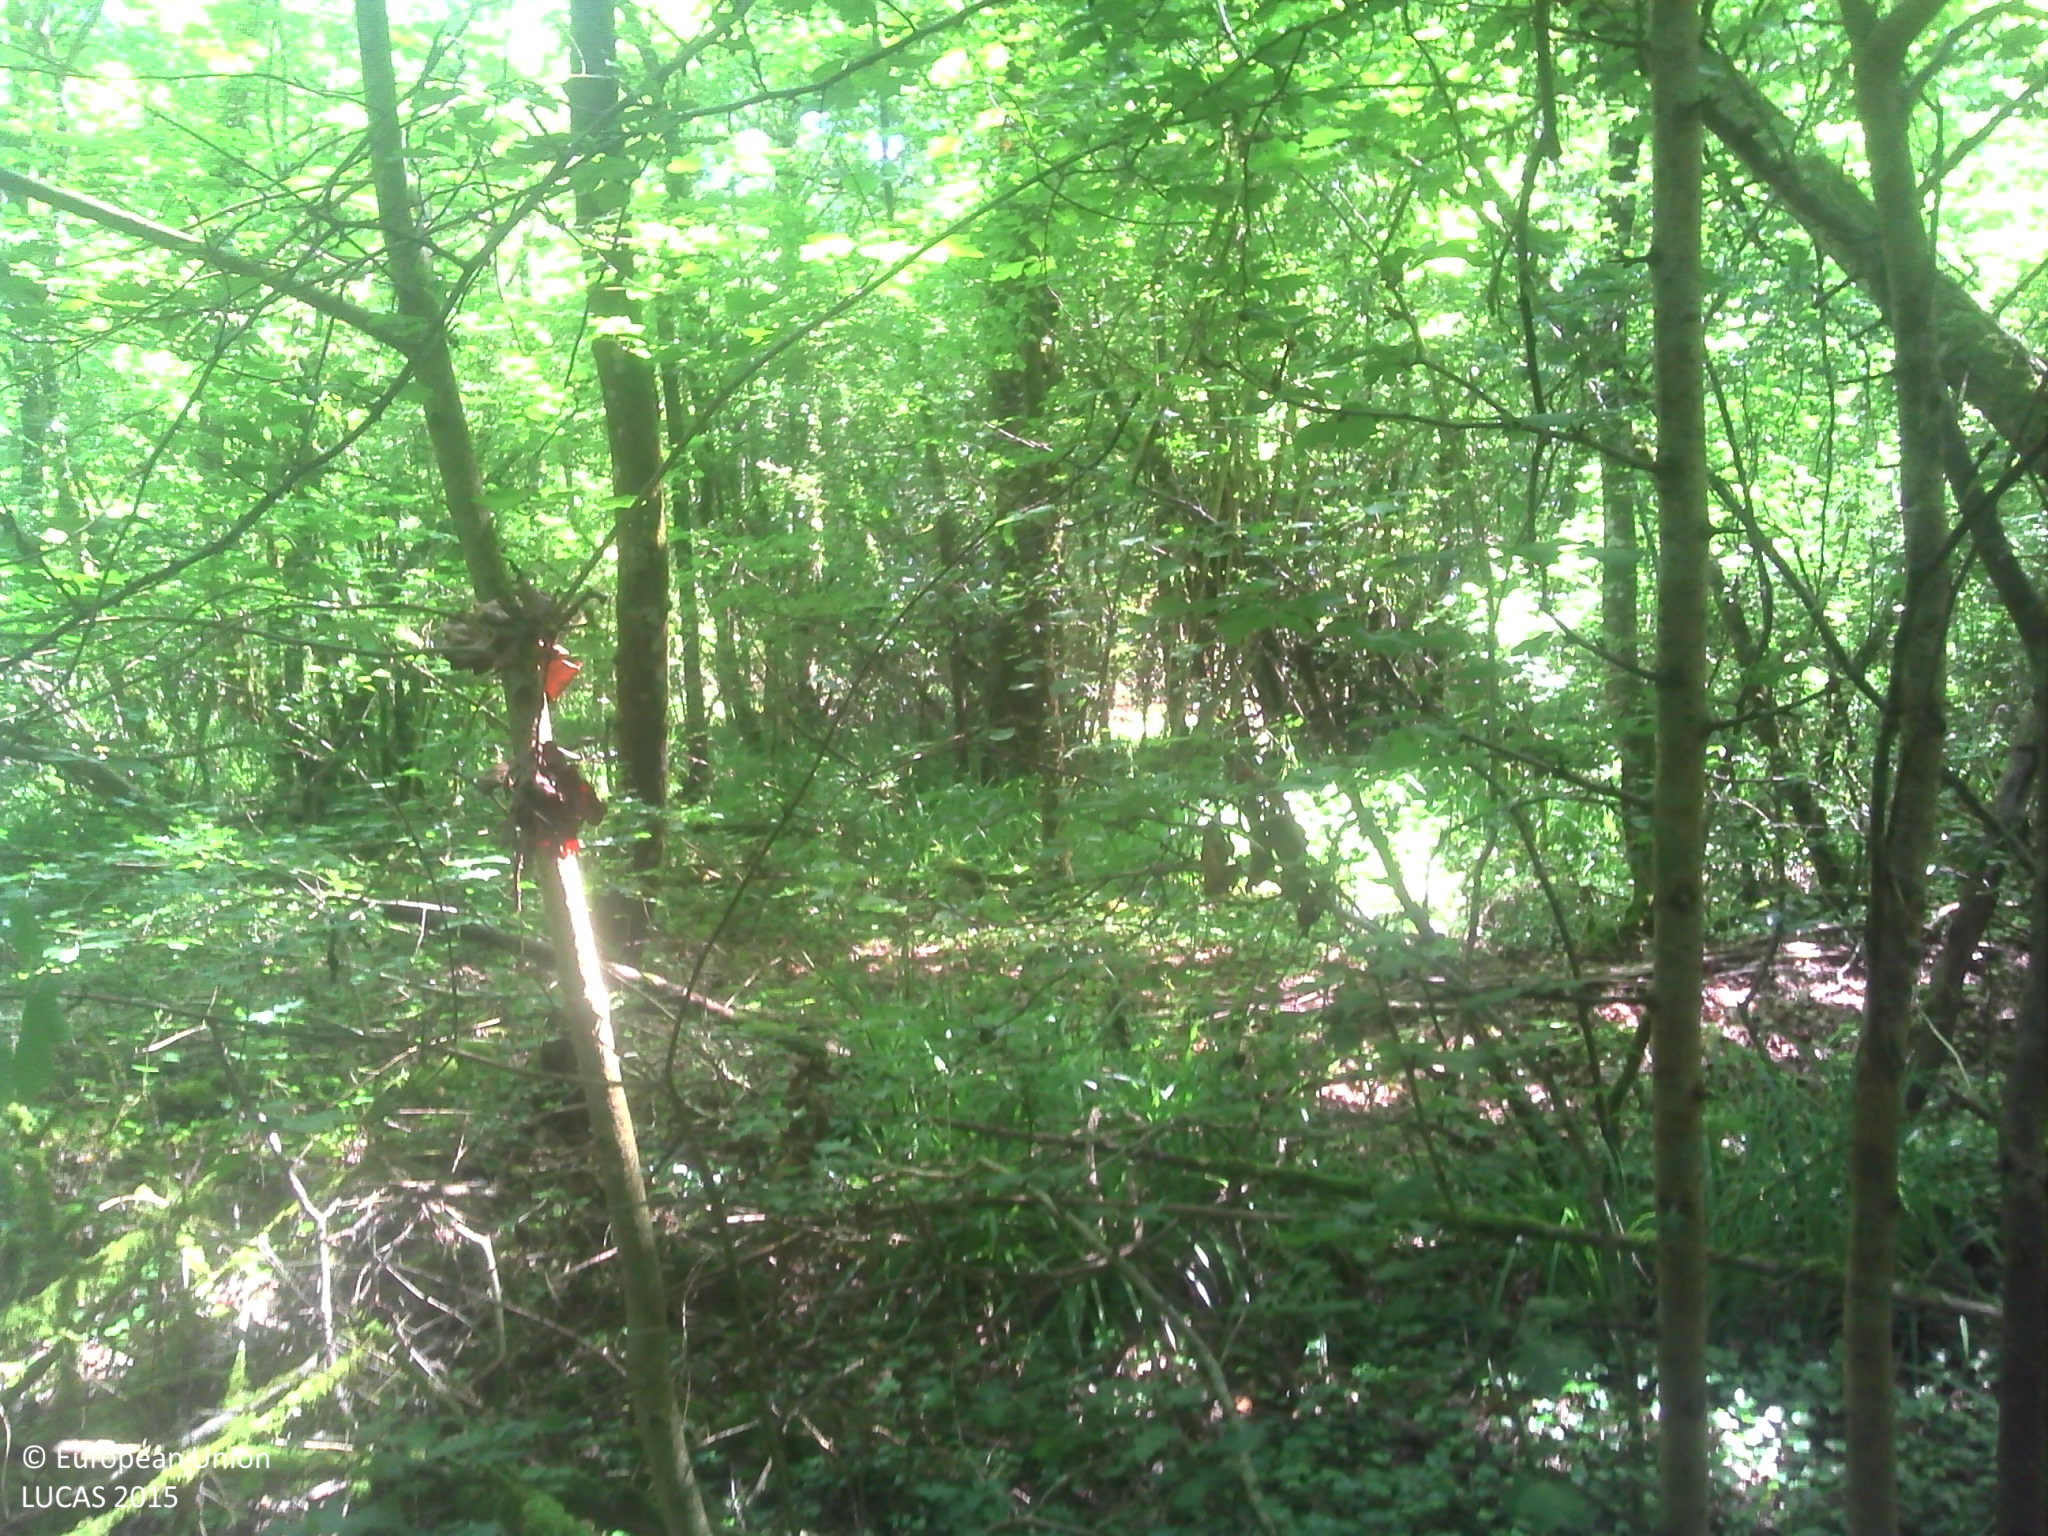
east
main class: Woodland
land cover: Broadleaved woodland
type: mesophytic deciduous forest
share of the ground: > 75 %
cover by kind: broadleaved forest trees 90 %, herbaceous plants 10 %
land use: Forestry
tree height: > 5 m
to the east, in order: Broadleaved woodland; Tracks; Broadleaved woodland; Fences; Grassland without tree/shrub cover; Fences; Grassland without tree/shrub cover
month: June
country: FR
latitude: 48.4419
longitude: 4.7664
